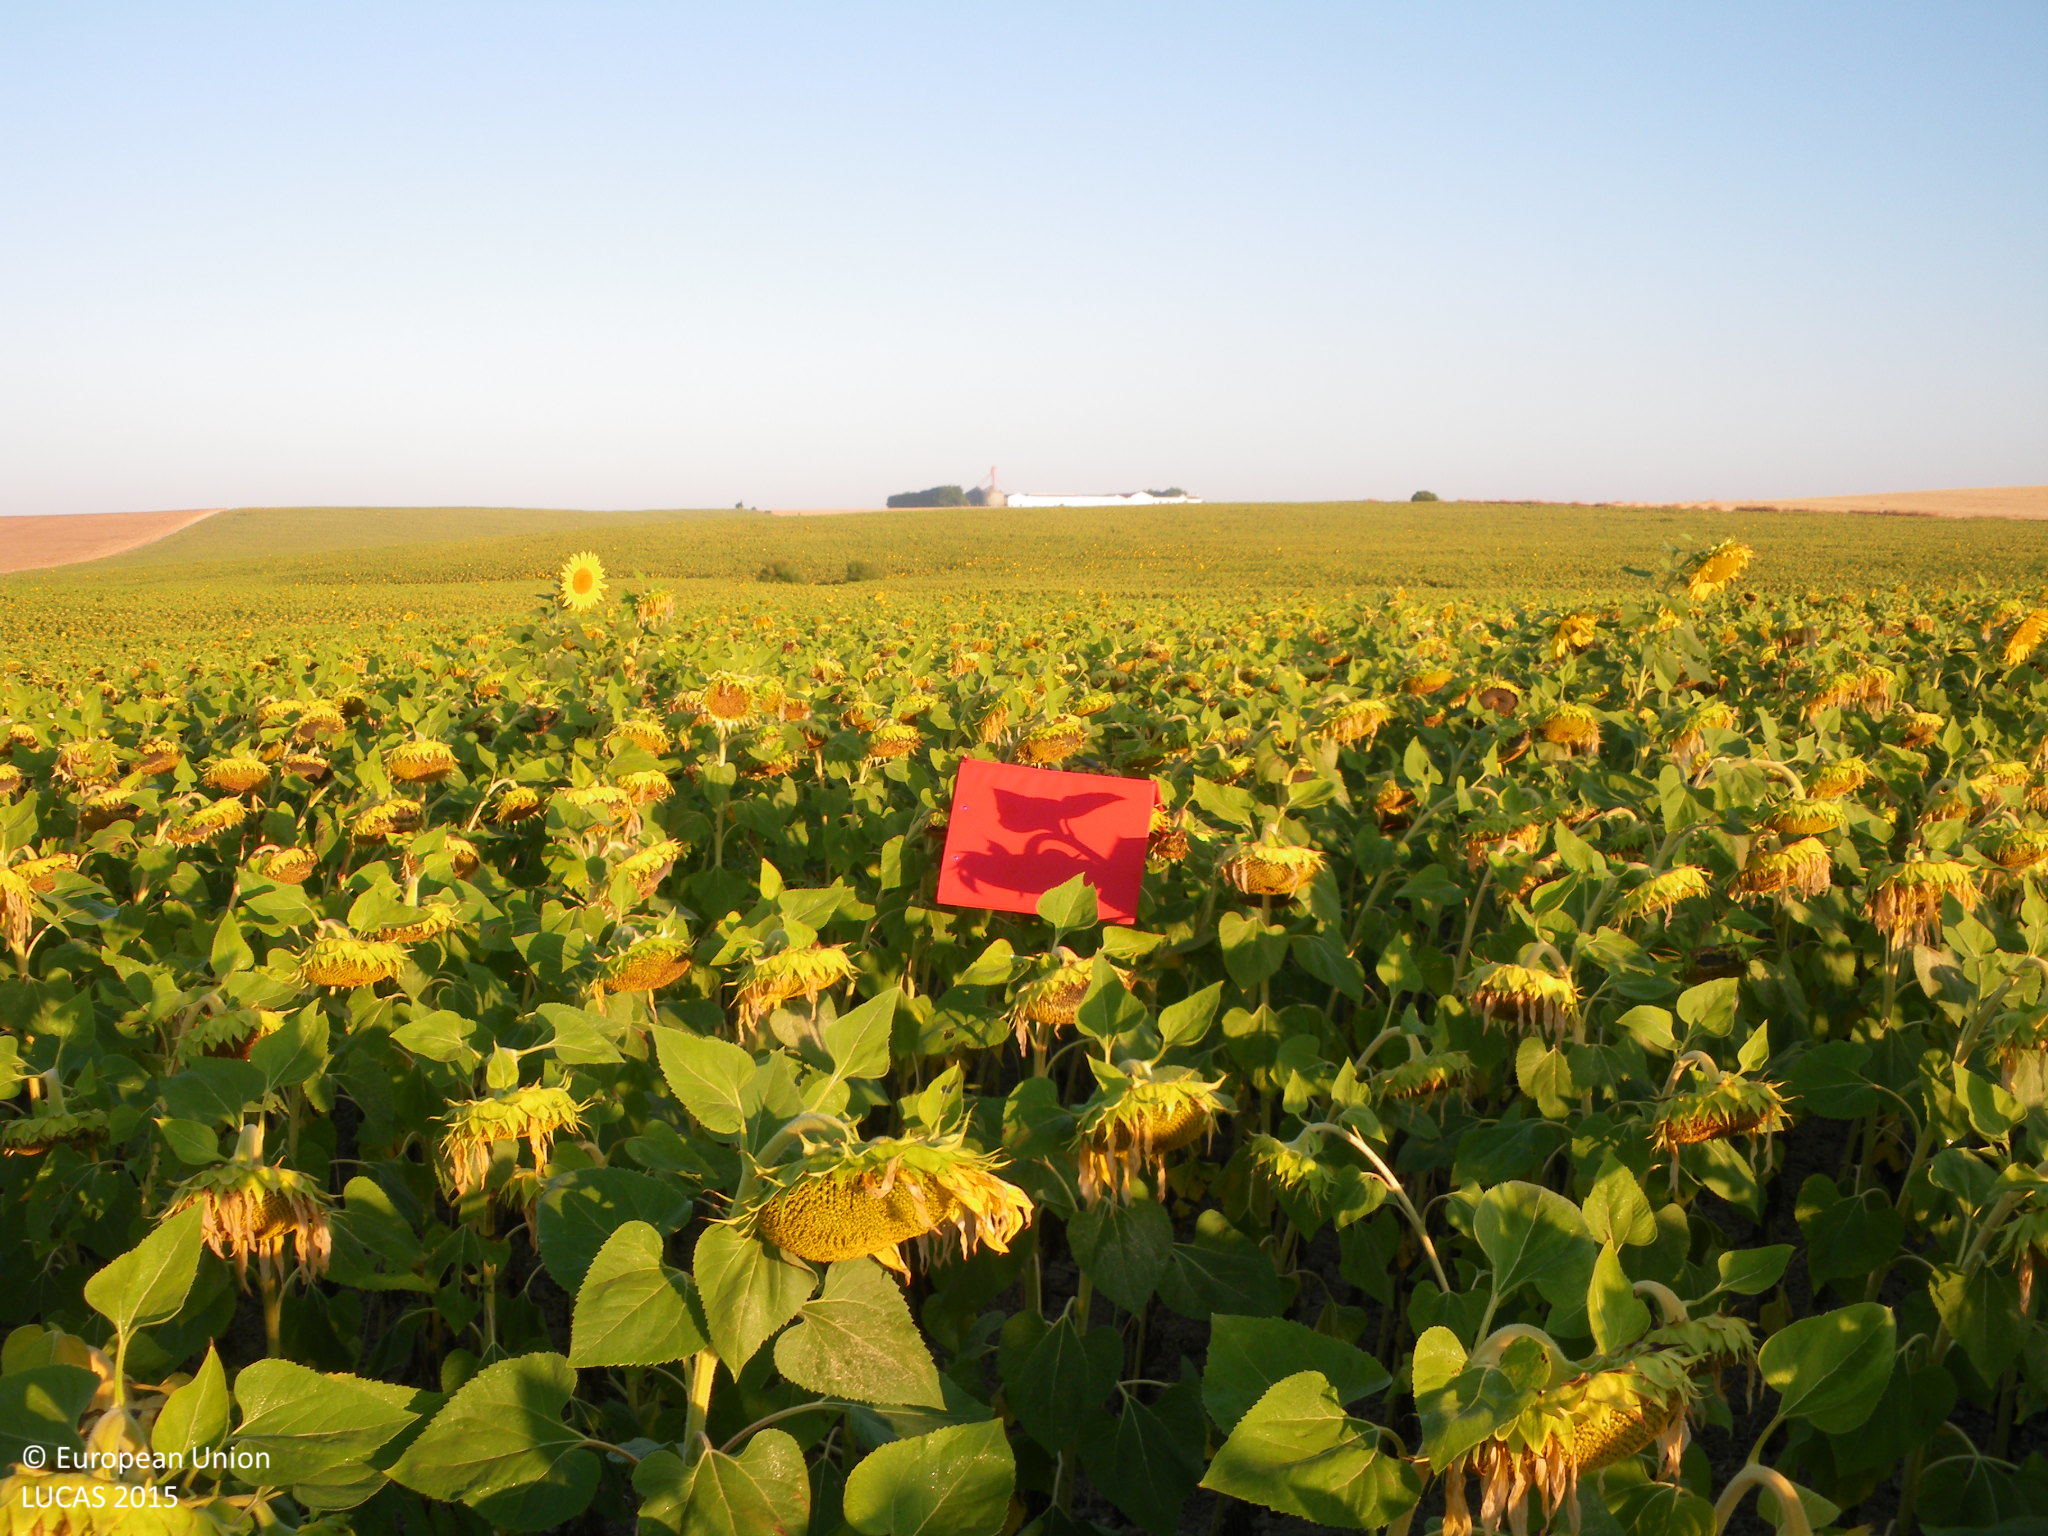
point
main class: Cropland
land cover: Sunflower
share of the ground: > 75 %
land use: Agriculture (excluding fallow land and kitchen gardens)
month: June
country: ES
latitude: 36.7643
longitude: -5.9294
